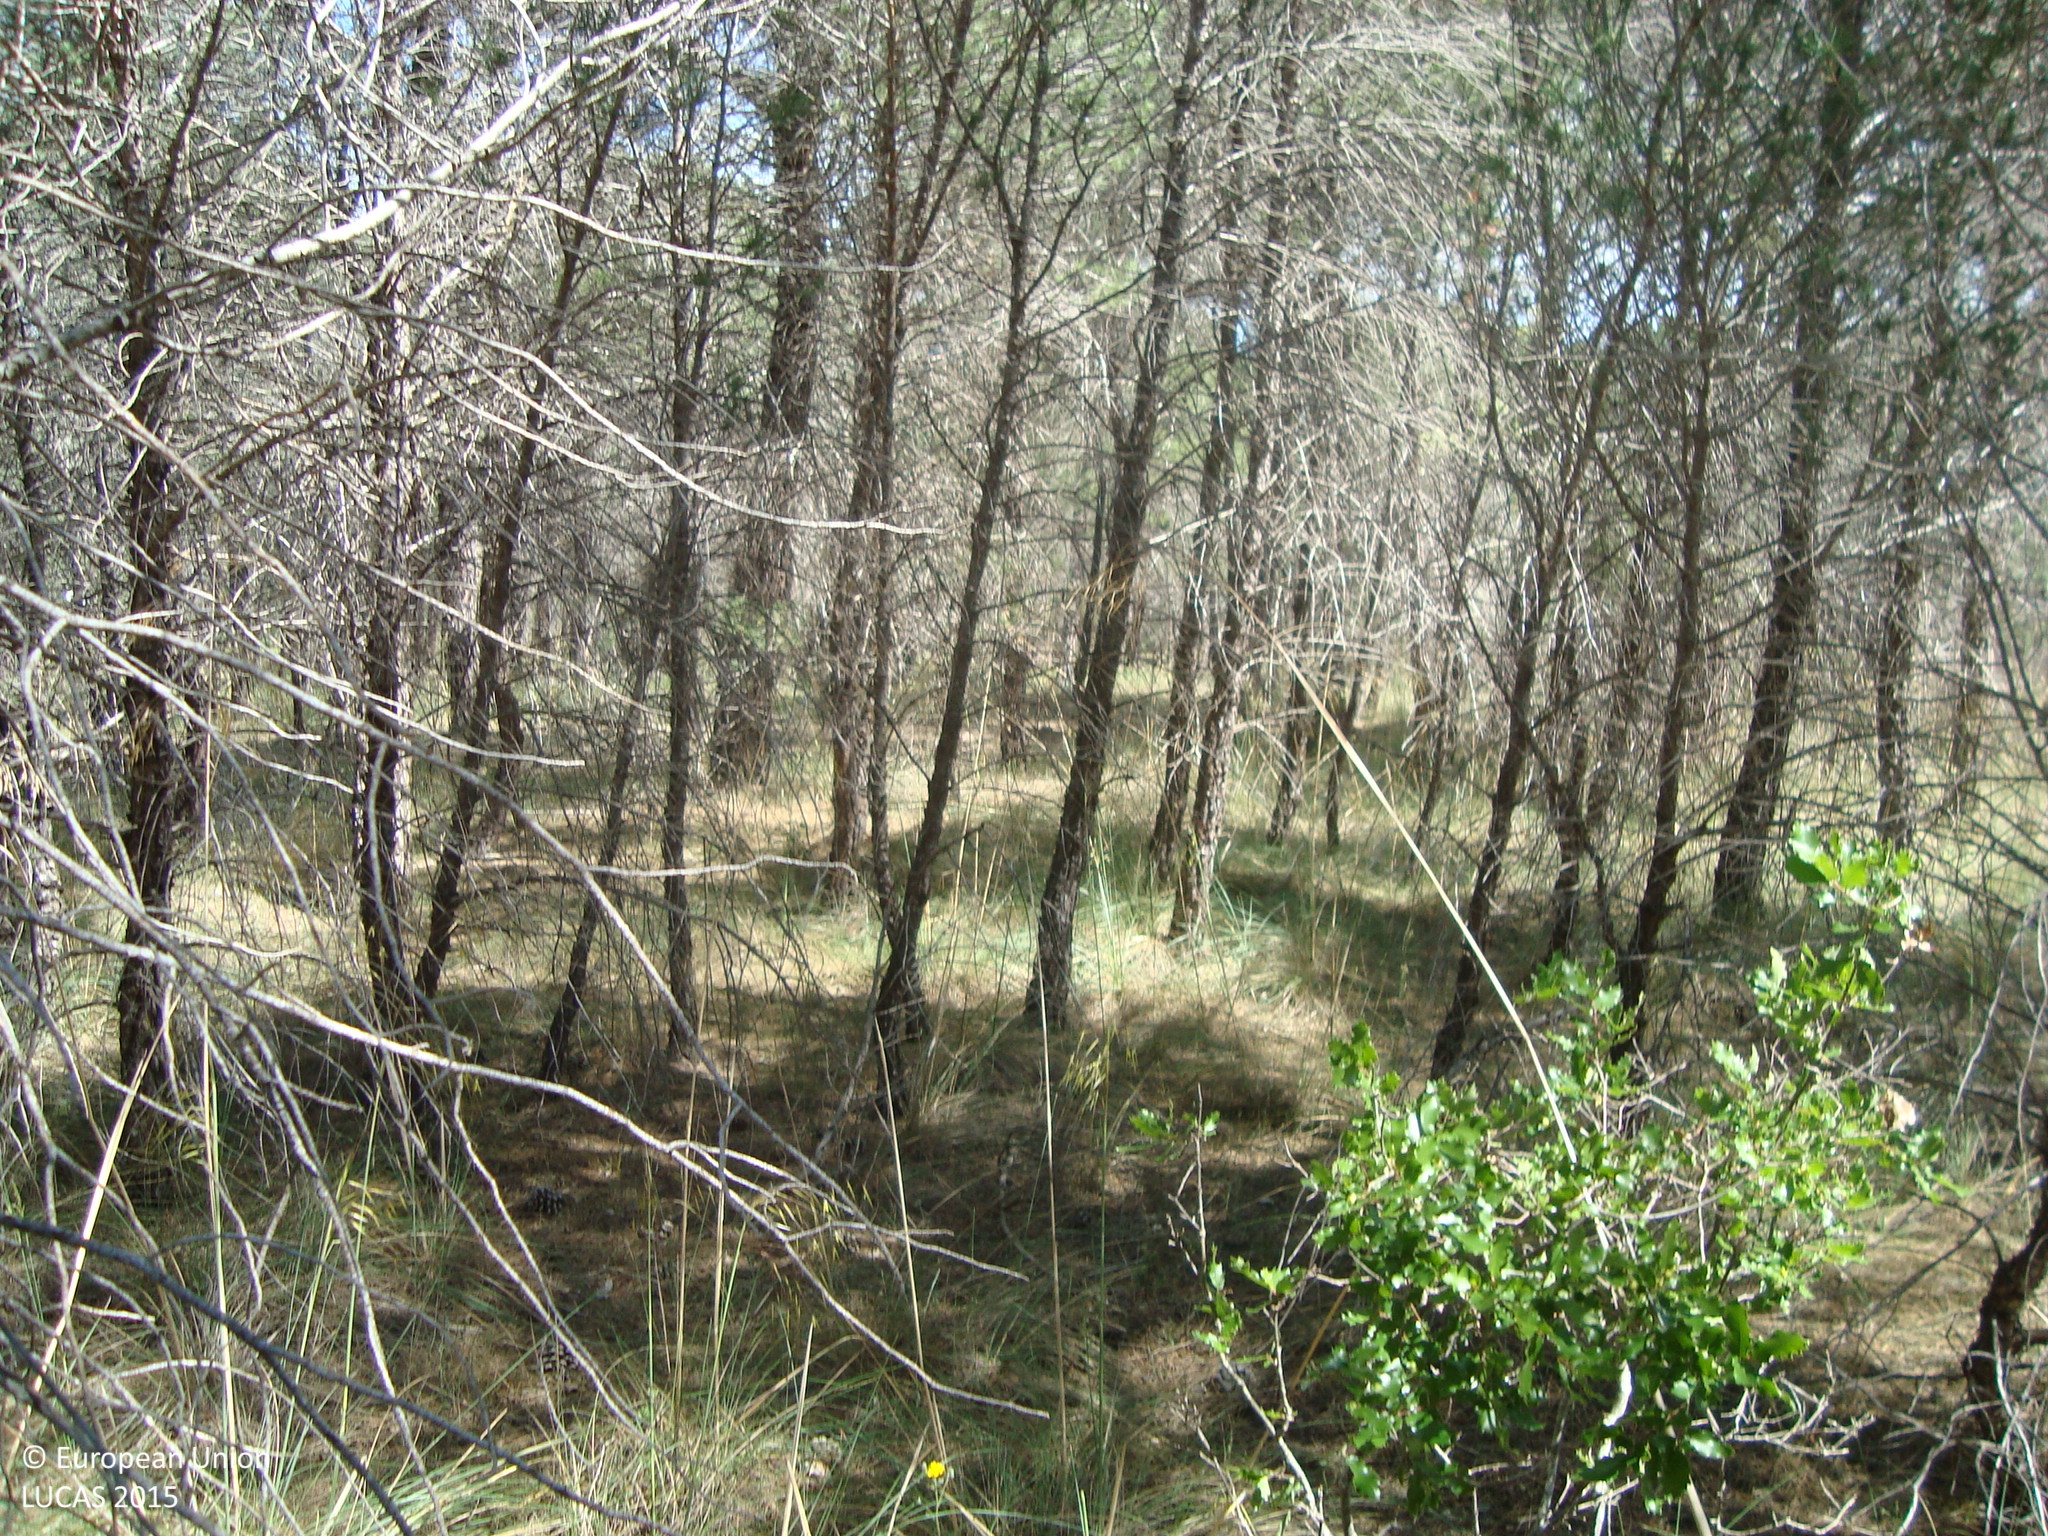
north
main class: Woodland
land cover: Pine dominated mixed woodland
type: coniferous forest of the mediterranean region
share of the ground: > 75 %
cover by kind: coniferous forest trees 55 %, broadleaved forest trees 25 %, shrubs 10 %, herbaceous plants 10 %
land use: Semi-natural and natural areas not in use
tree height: > 5 m
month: May
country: ES
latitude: 41.6345
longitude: -4.1647
